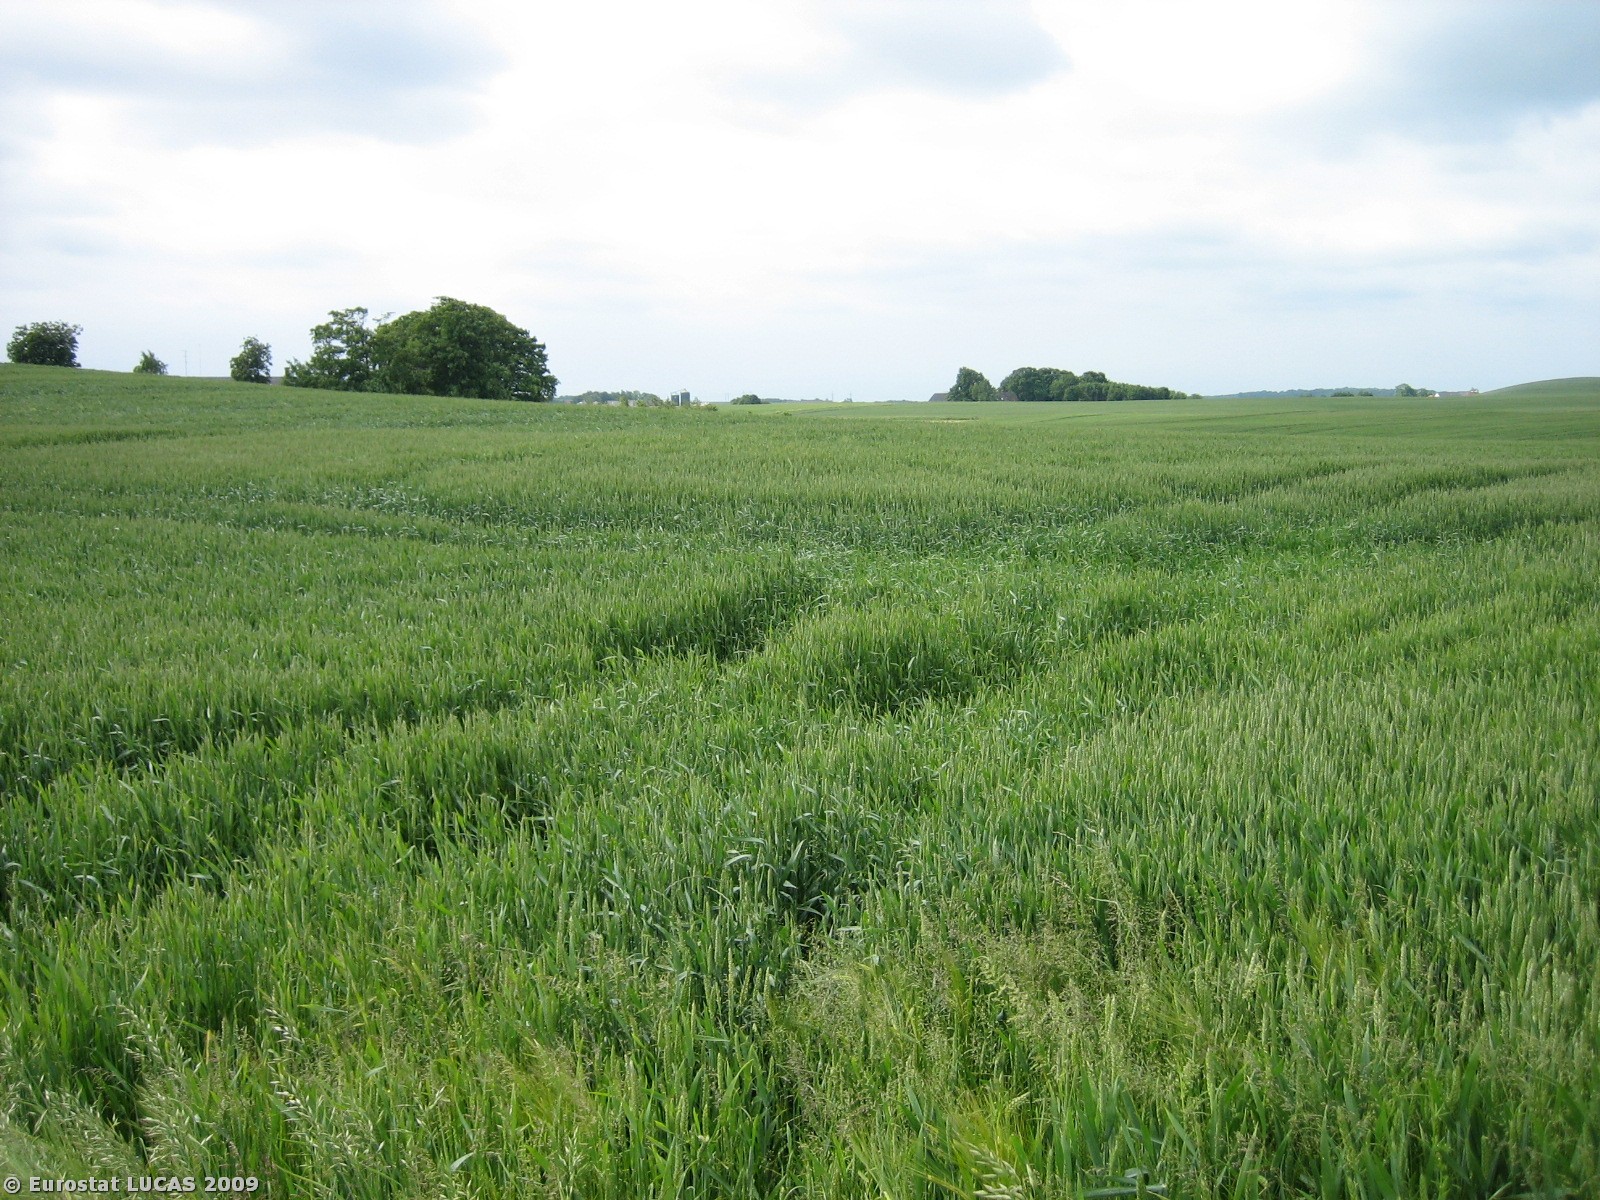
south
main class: Cropland
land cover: Common wheat
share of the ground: > 75 %
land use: Agriculture (excluding fallow land and kitchen gardens)
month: June
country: DK
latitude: 55.9361
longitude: 10.0160
